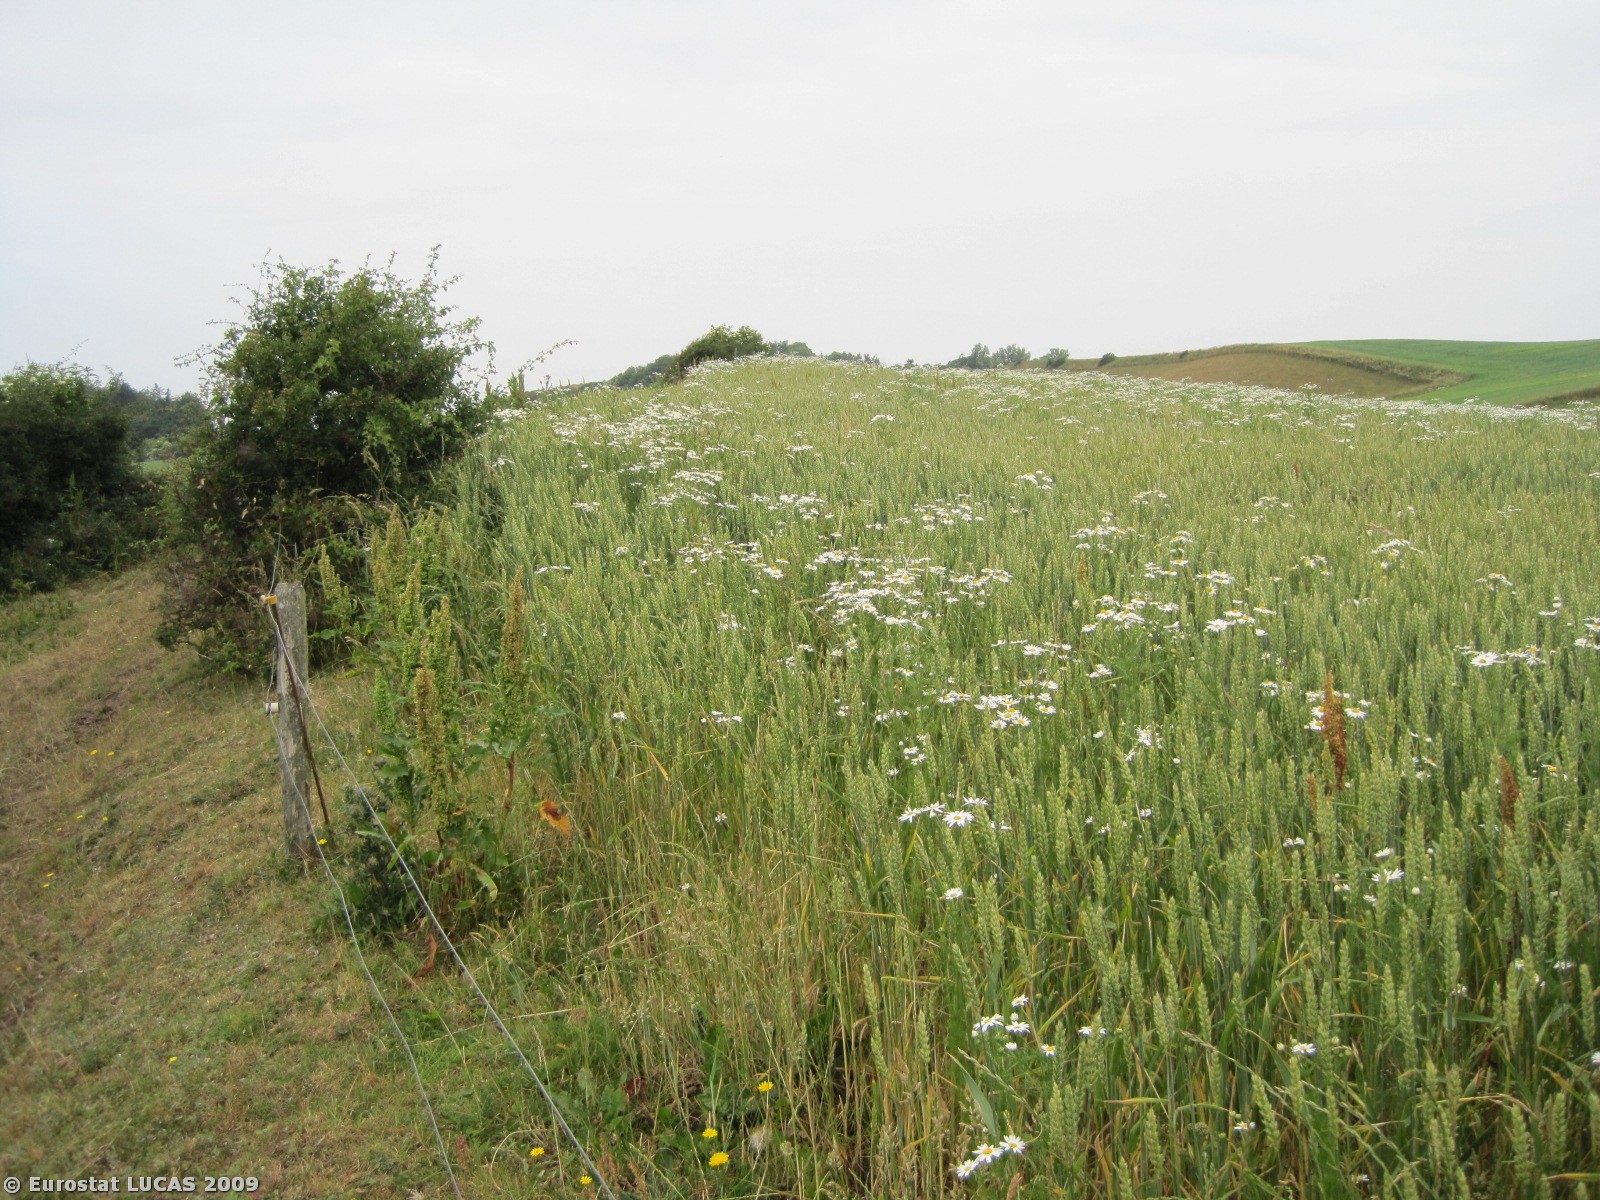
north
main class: Grassland
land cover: Grassland with sparse tree/shrub cover
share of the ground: > 75 %
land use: Agriculture (excluding fallow land and kitchen gardens)
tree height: < 5 m
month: June
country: DK
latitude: 56.5365
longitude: 8.3272
